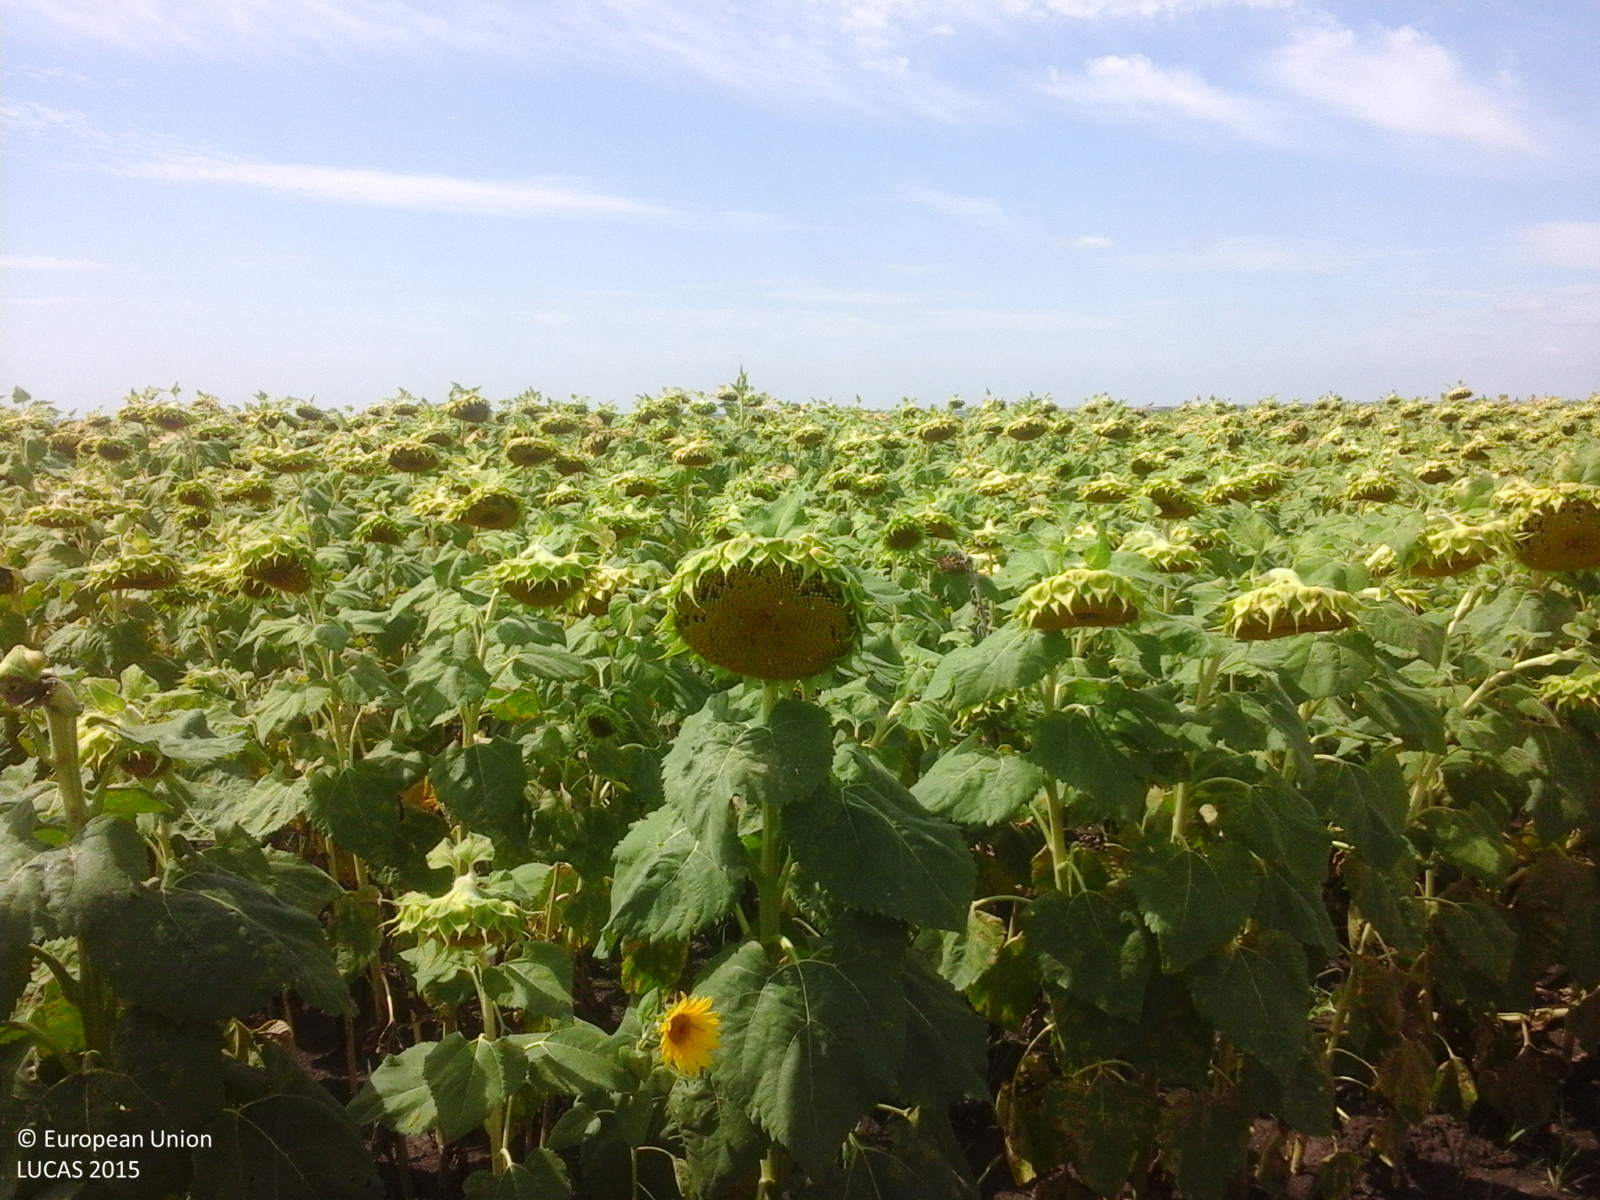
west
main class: Cropland
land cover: Sunflower
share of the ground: > 75 %
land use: Agriculture (excluding fallow land and kitchen gardens)
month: August
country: RO
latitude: 45.3039
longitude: 21.3932
